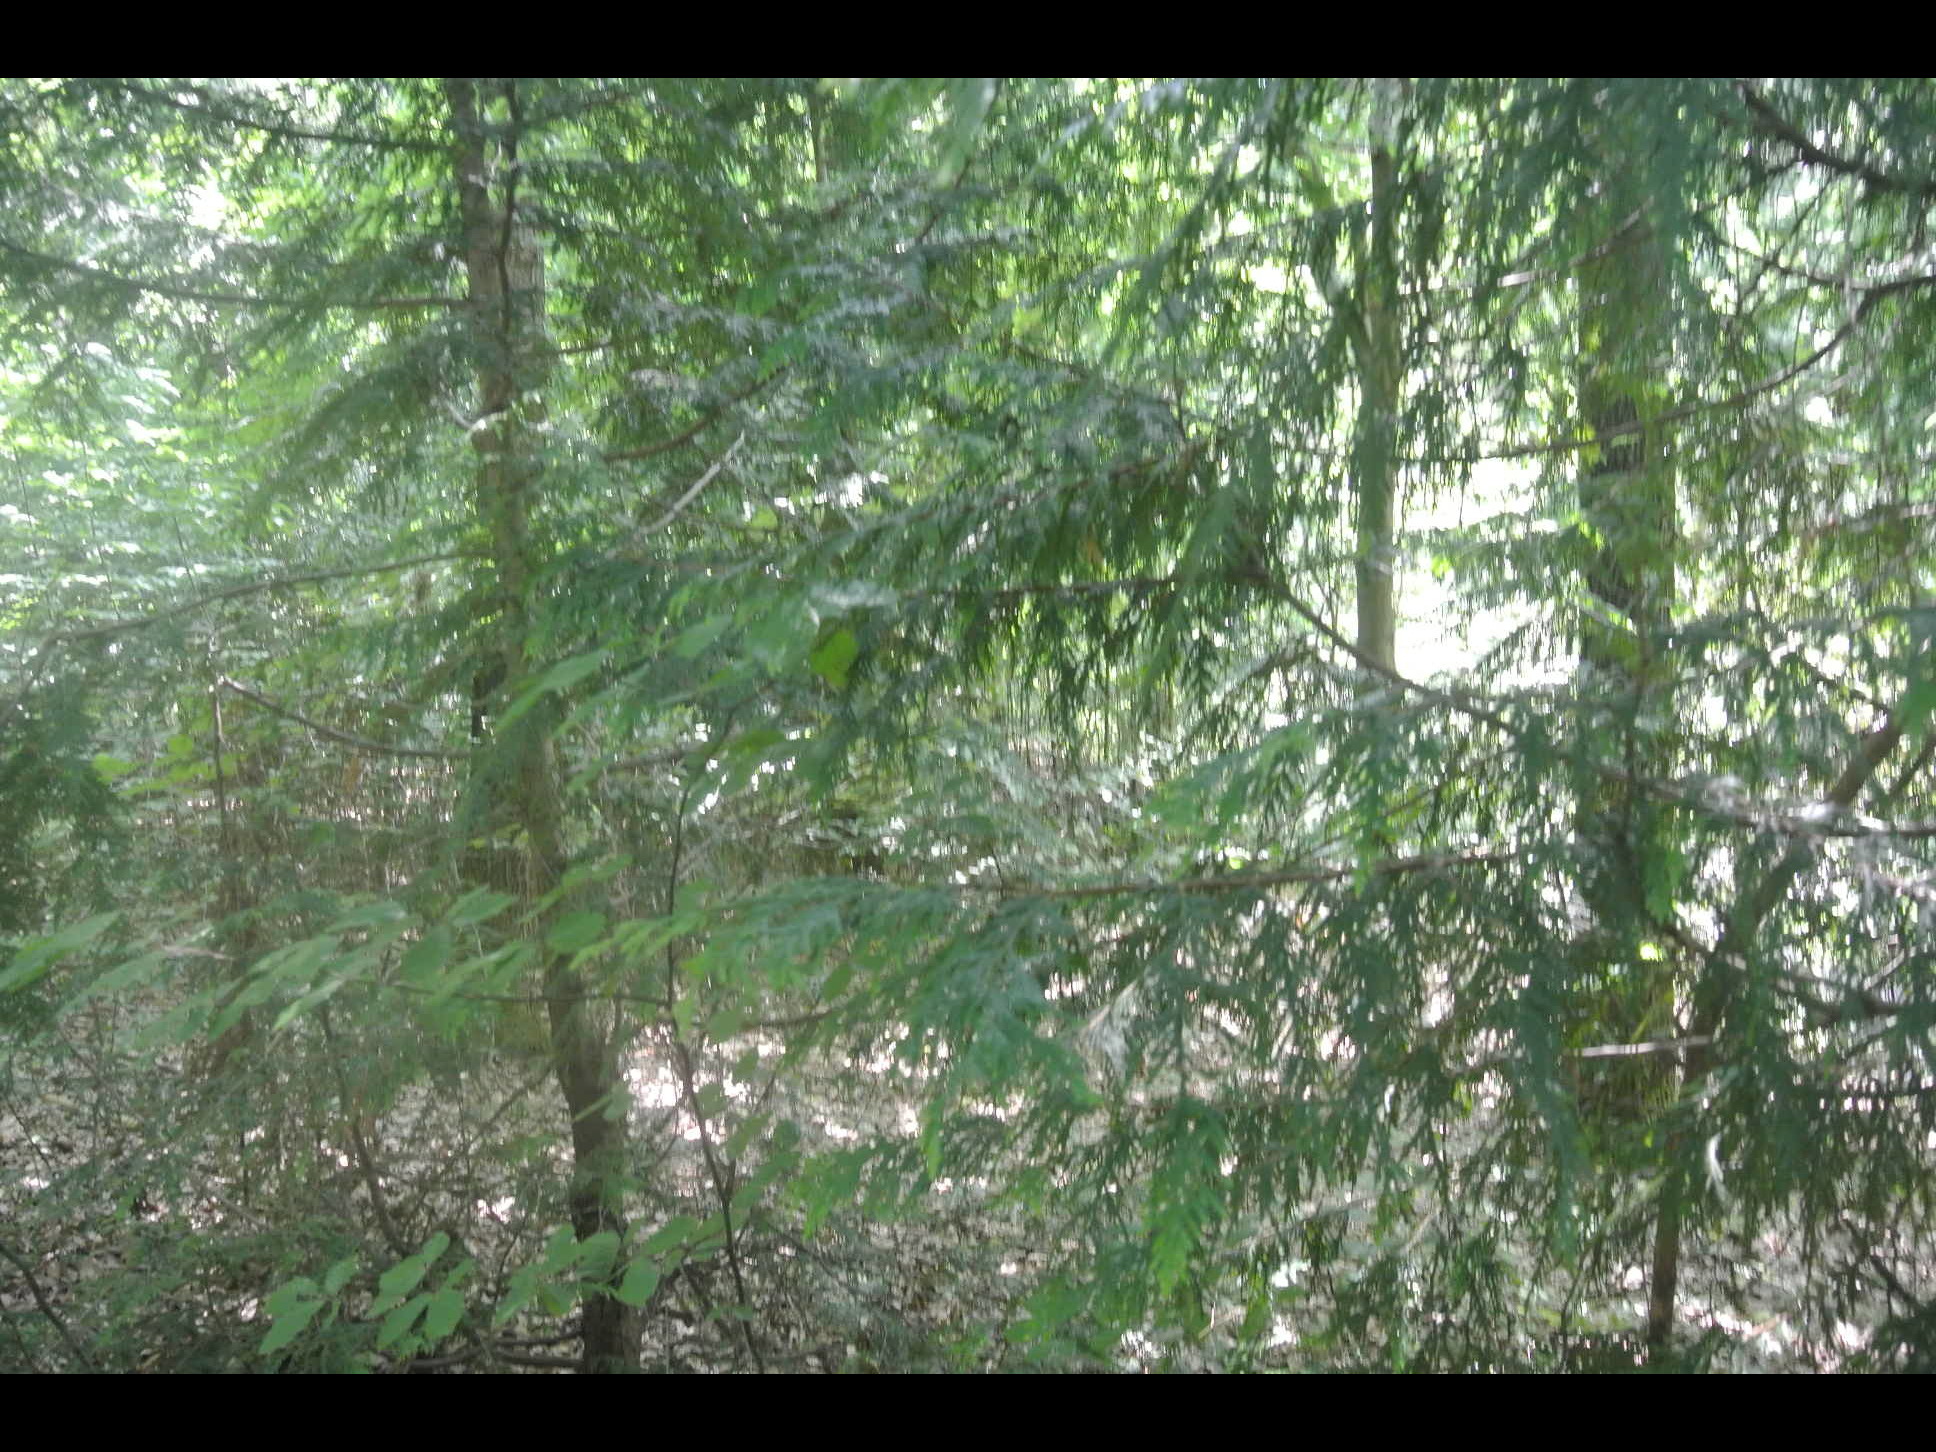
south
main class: Woodland
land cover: Broadleaved woodland
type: beech forest
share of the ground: > 75 %
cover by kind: broadleaved forest trees 95 %, coniferous forest trees 5 %
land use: Forestry
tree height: > 5 m
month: July
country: AT
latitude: 47.4039
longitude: 16.4301
